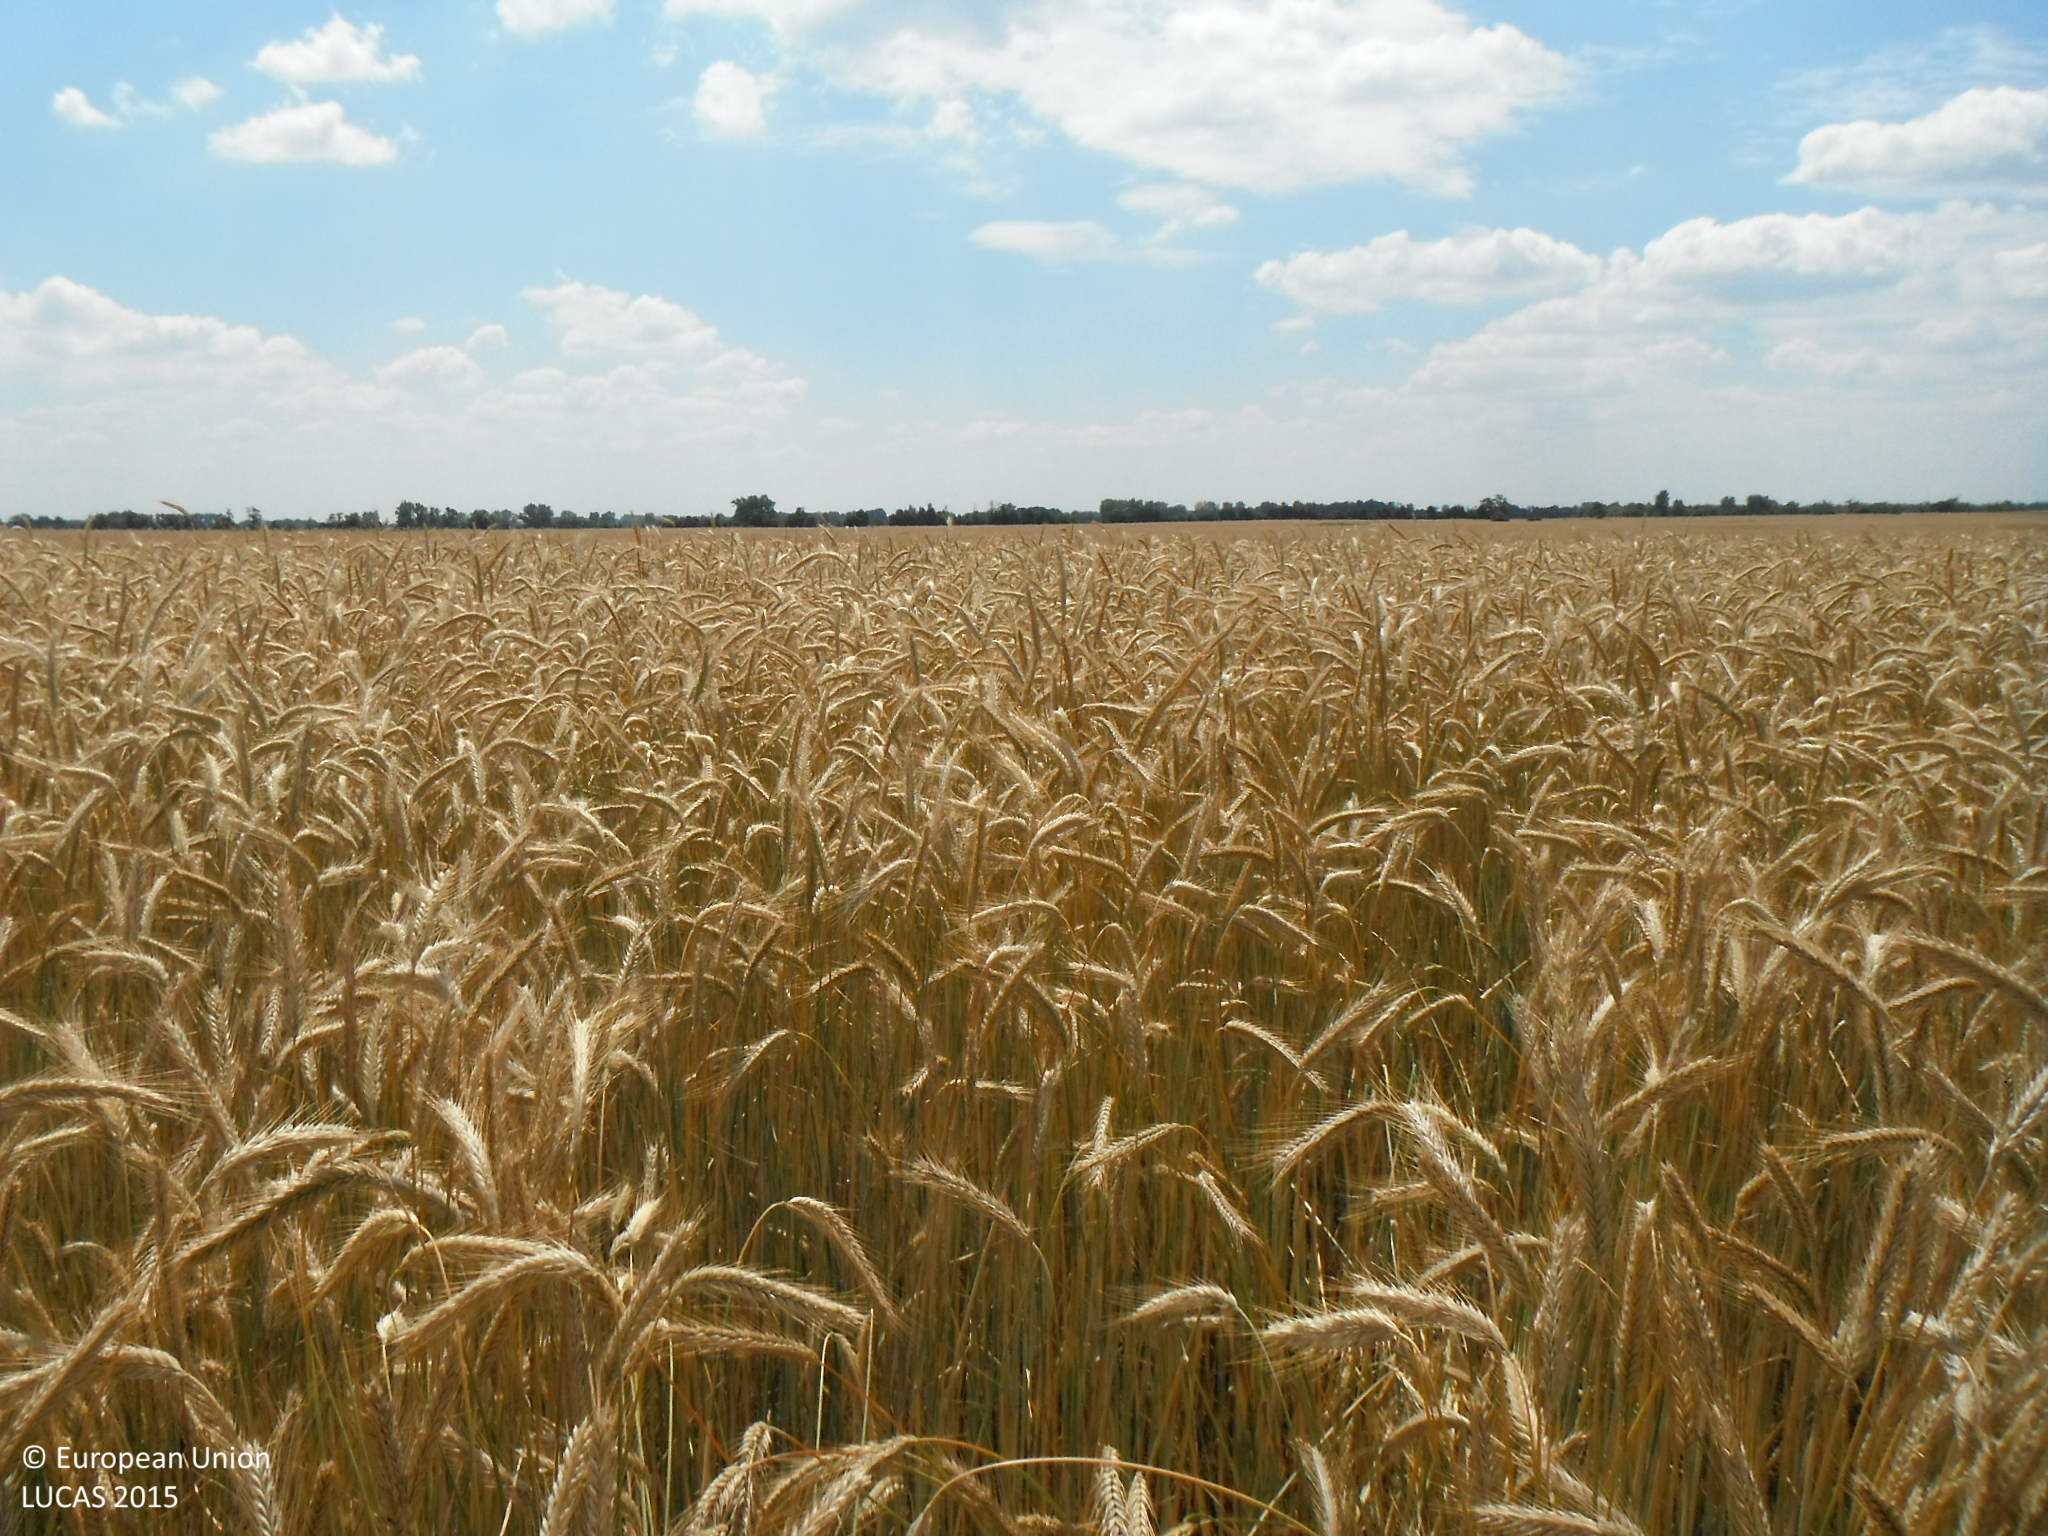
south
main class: Cropland
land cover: Triticale
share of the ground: > 75 %
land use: Agriculture (excluding fallow land and kitchen gardens)
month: June
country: SK
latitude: 47.8629
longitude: 18.2073
